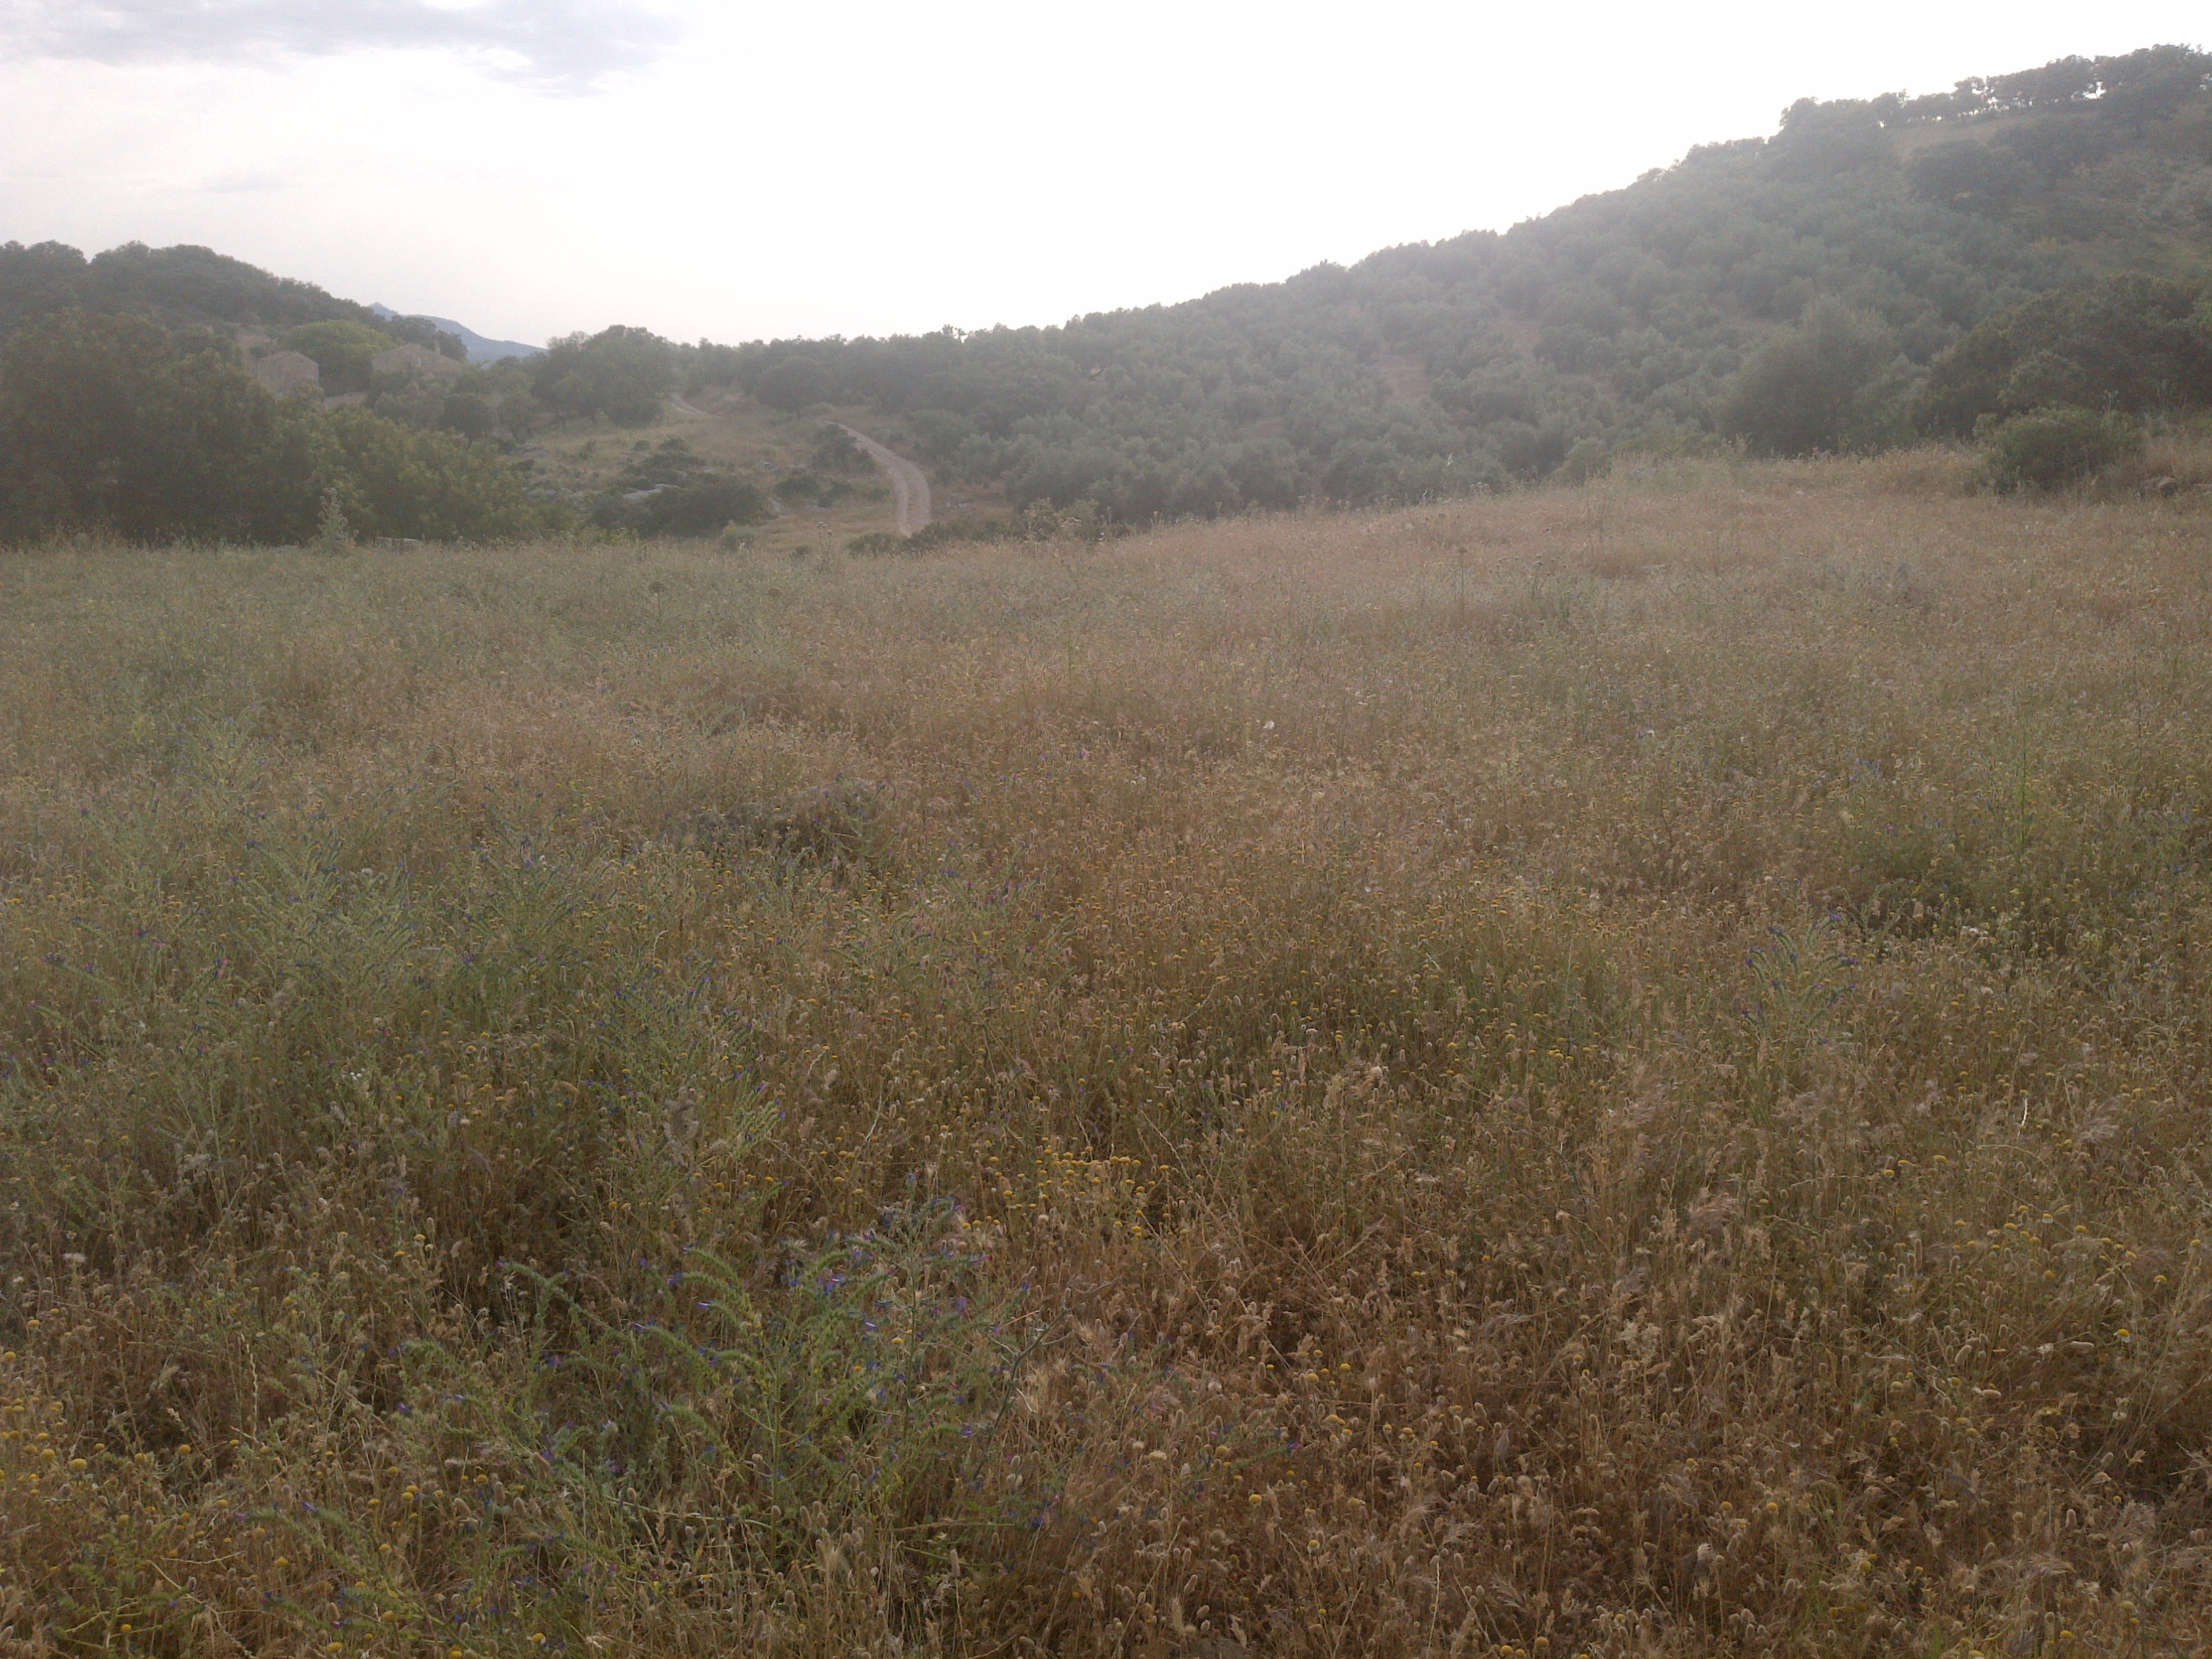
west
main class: Grassland
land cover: Grassland without tree/shrub cover
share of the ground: > 75 %
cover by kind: herbaceous plants 100 %
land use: Agriculture (excluding fallow land and kitchen gardens)
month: May
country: ES
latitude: 37.4053
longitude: -4.3599
